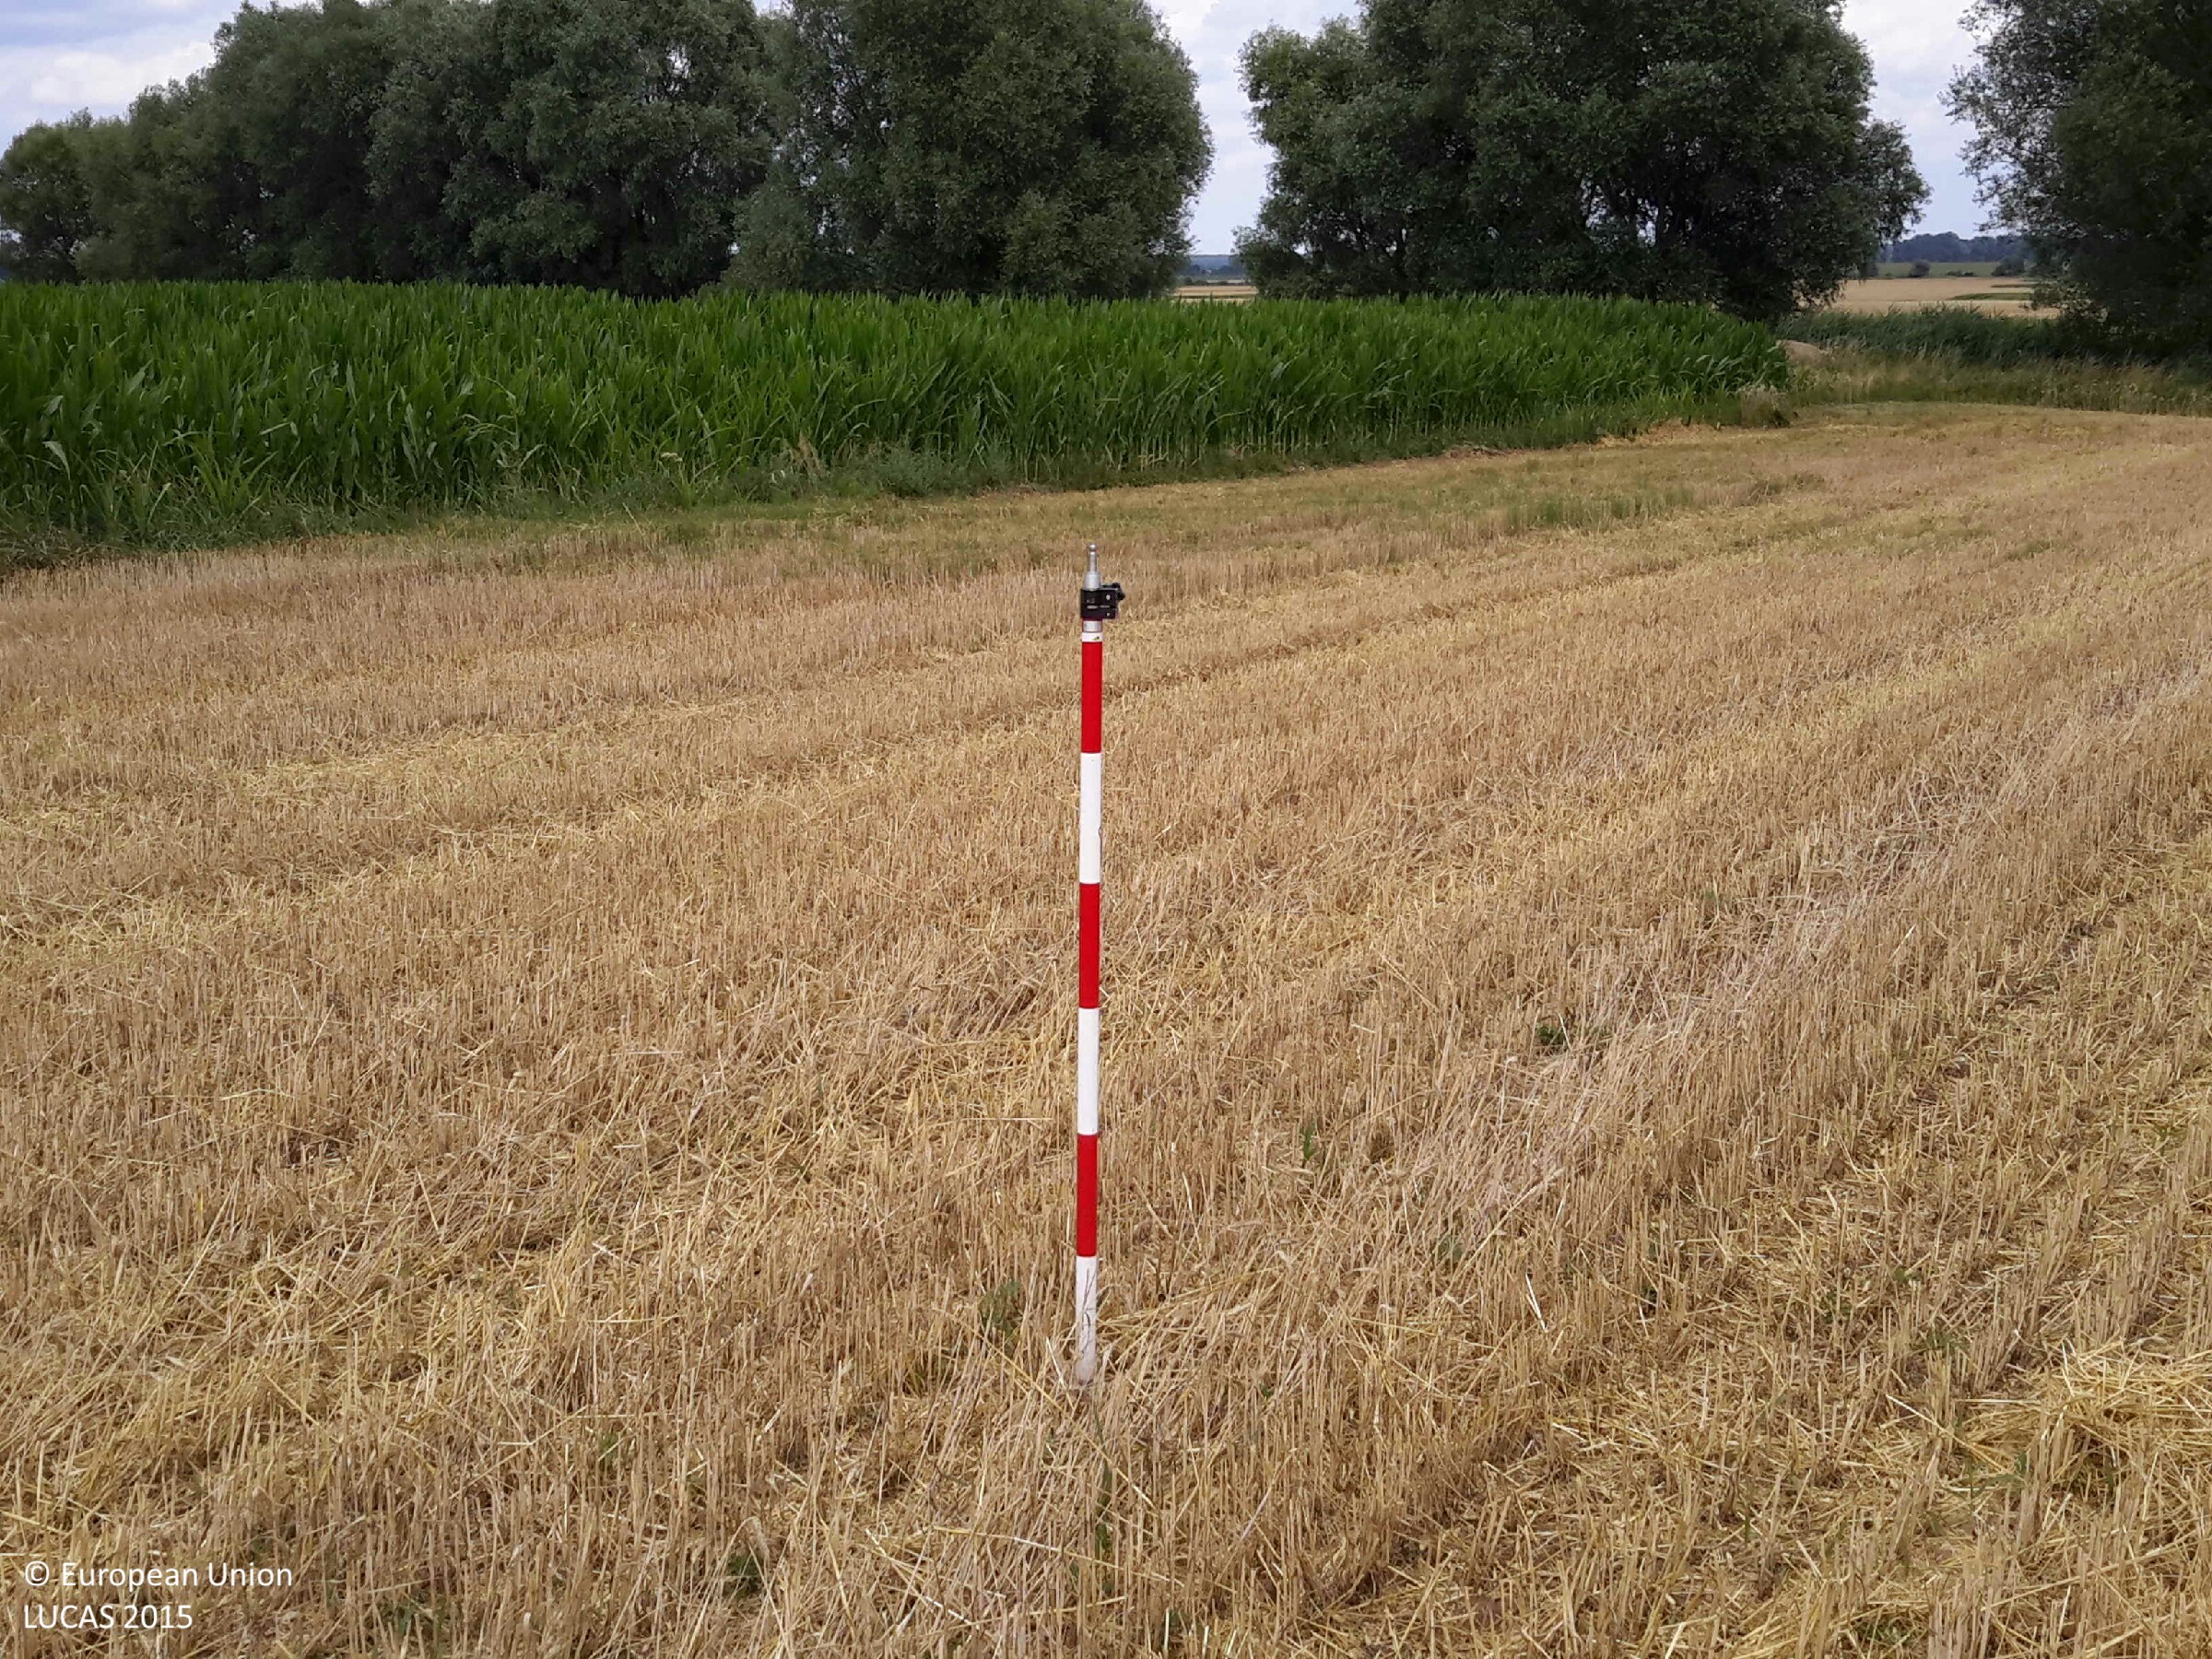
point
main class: Cropland
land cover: Common wheat
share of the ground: 25 - 50 %
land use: Agriculture (excluding fallow land and kitchen gardens)
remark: Harvested field
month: July
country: HU
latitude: 47.1659
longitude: 17.0628
